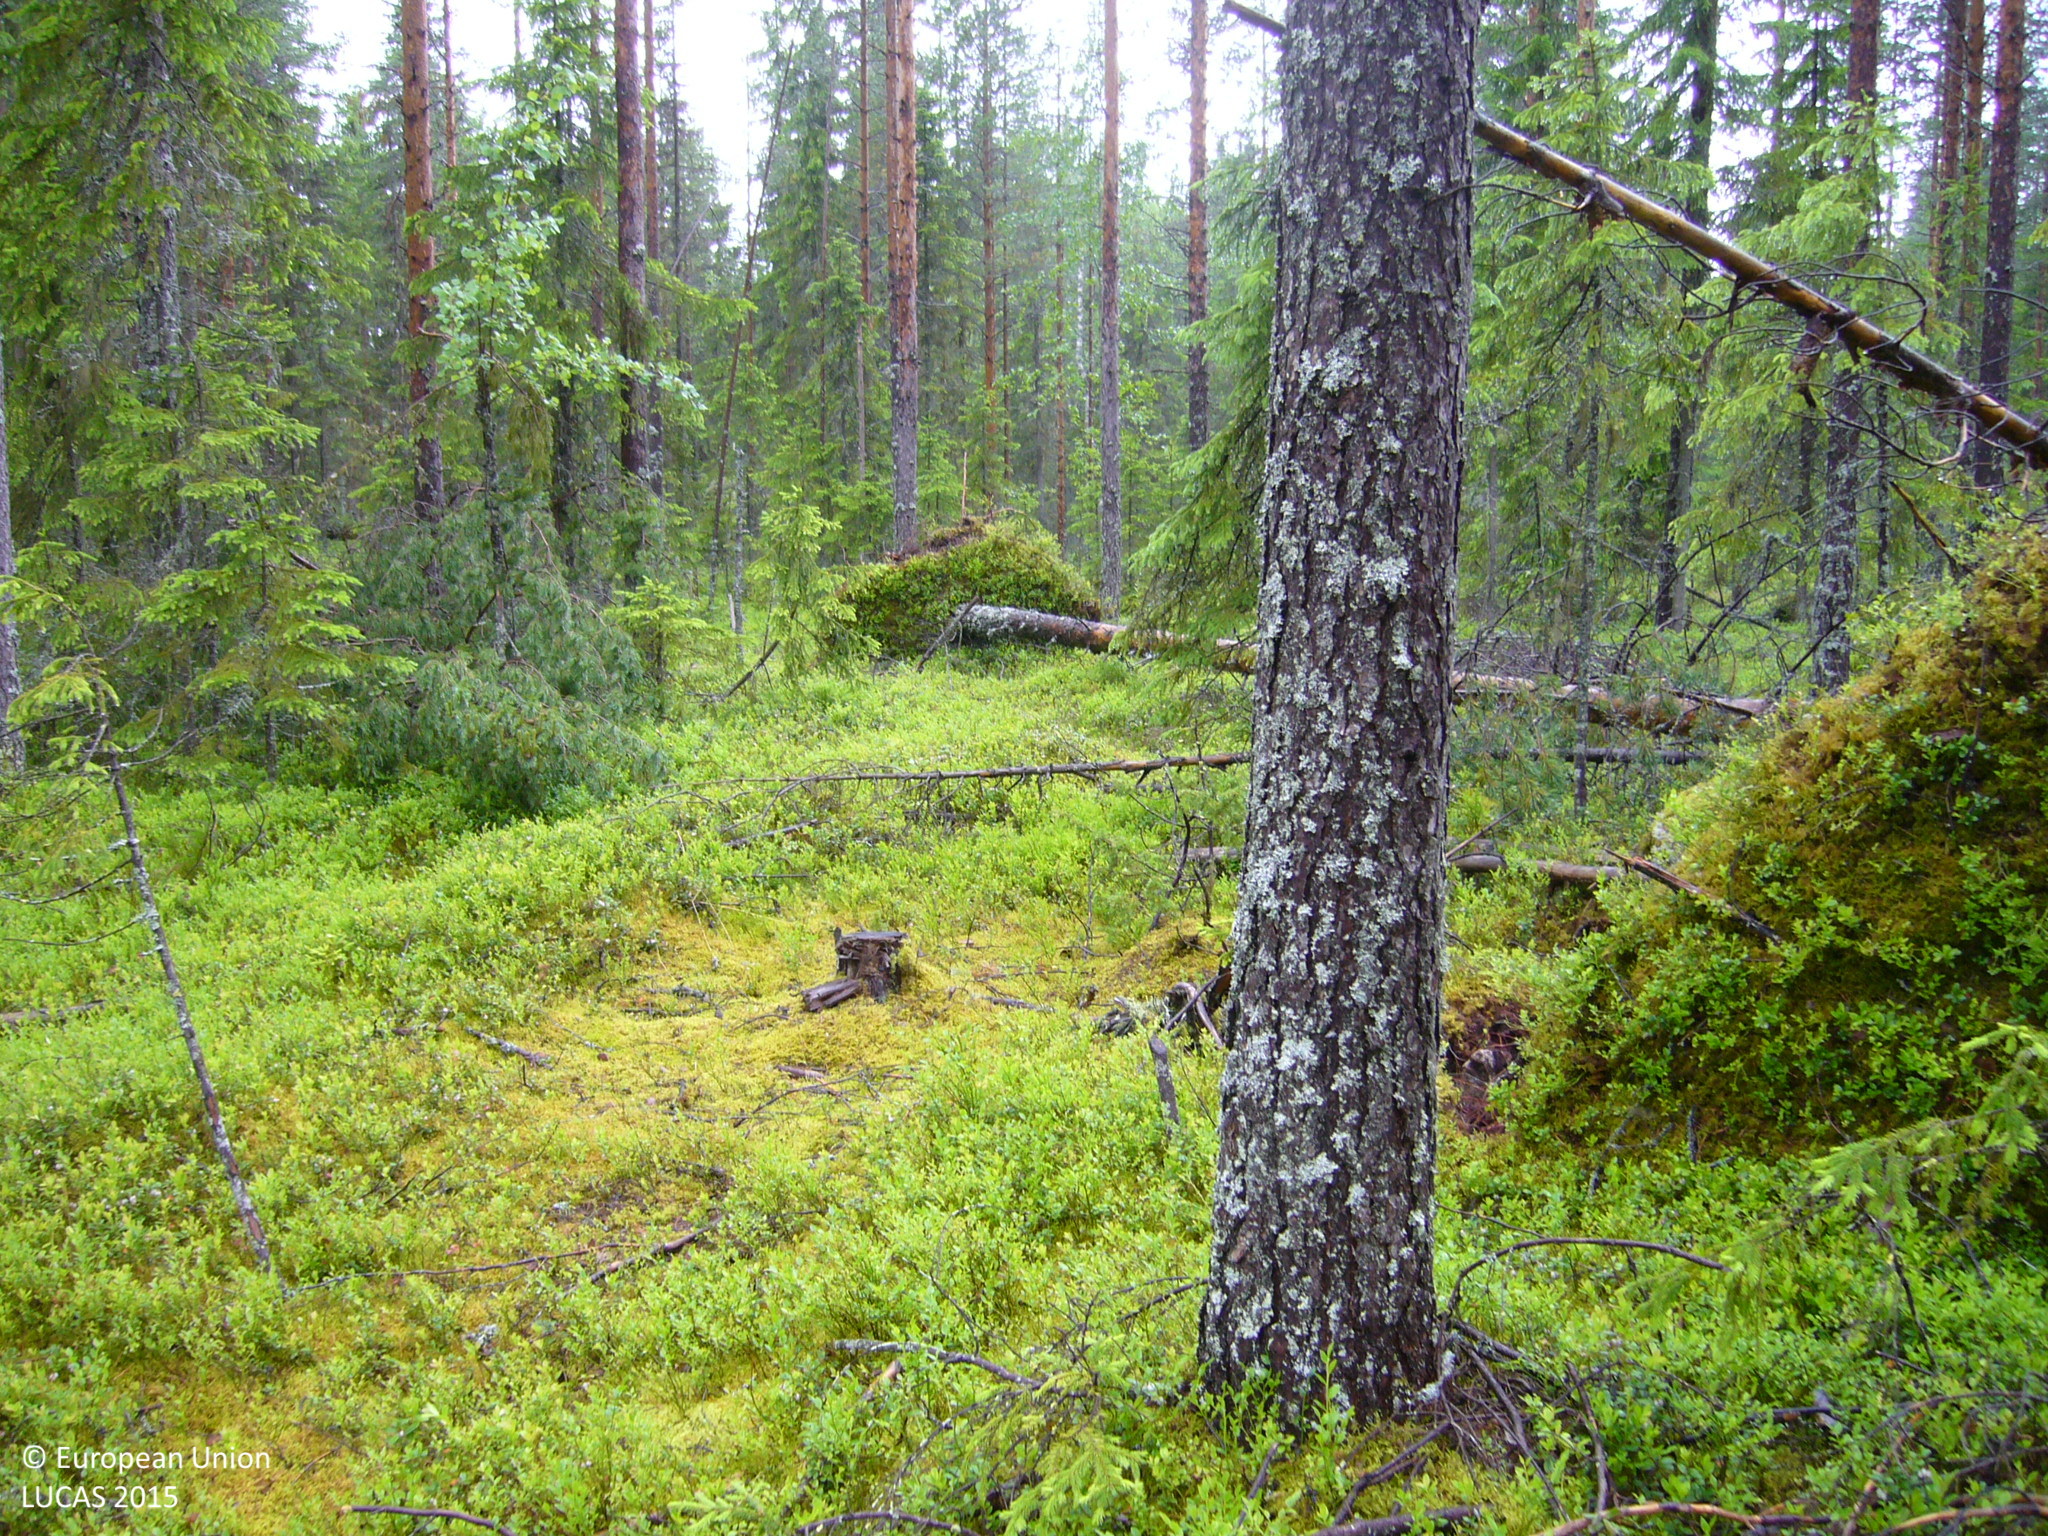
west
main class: Woodland
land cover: Pine dominated coniferous woodland
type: boreal forest
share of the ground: 50 - 75 %
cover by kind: coniferous forest trees 60 %, shrubs 40 %
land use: Forestry
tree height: > 5 m
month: June
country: FI
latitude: 63.7484
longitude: 26.1431
